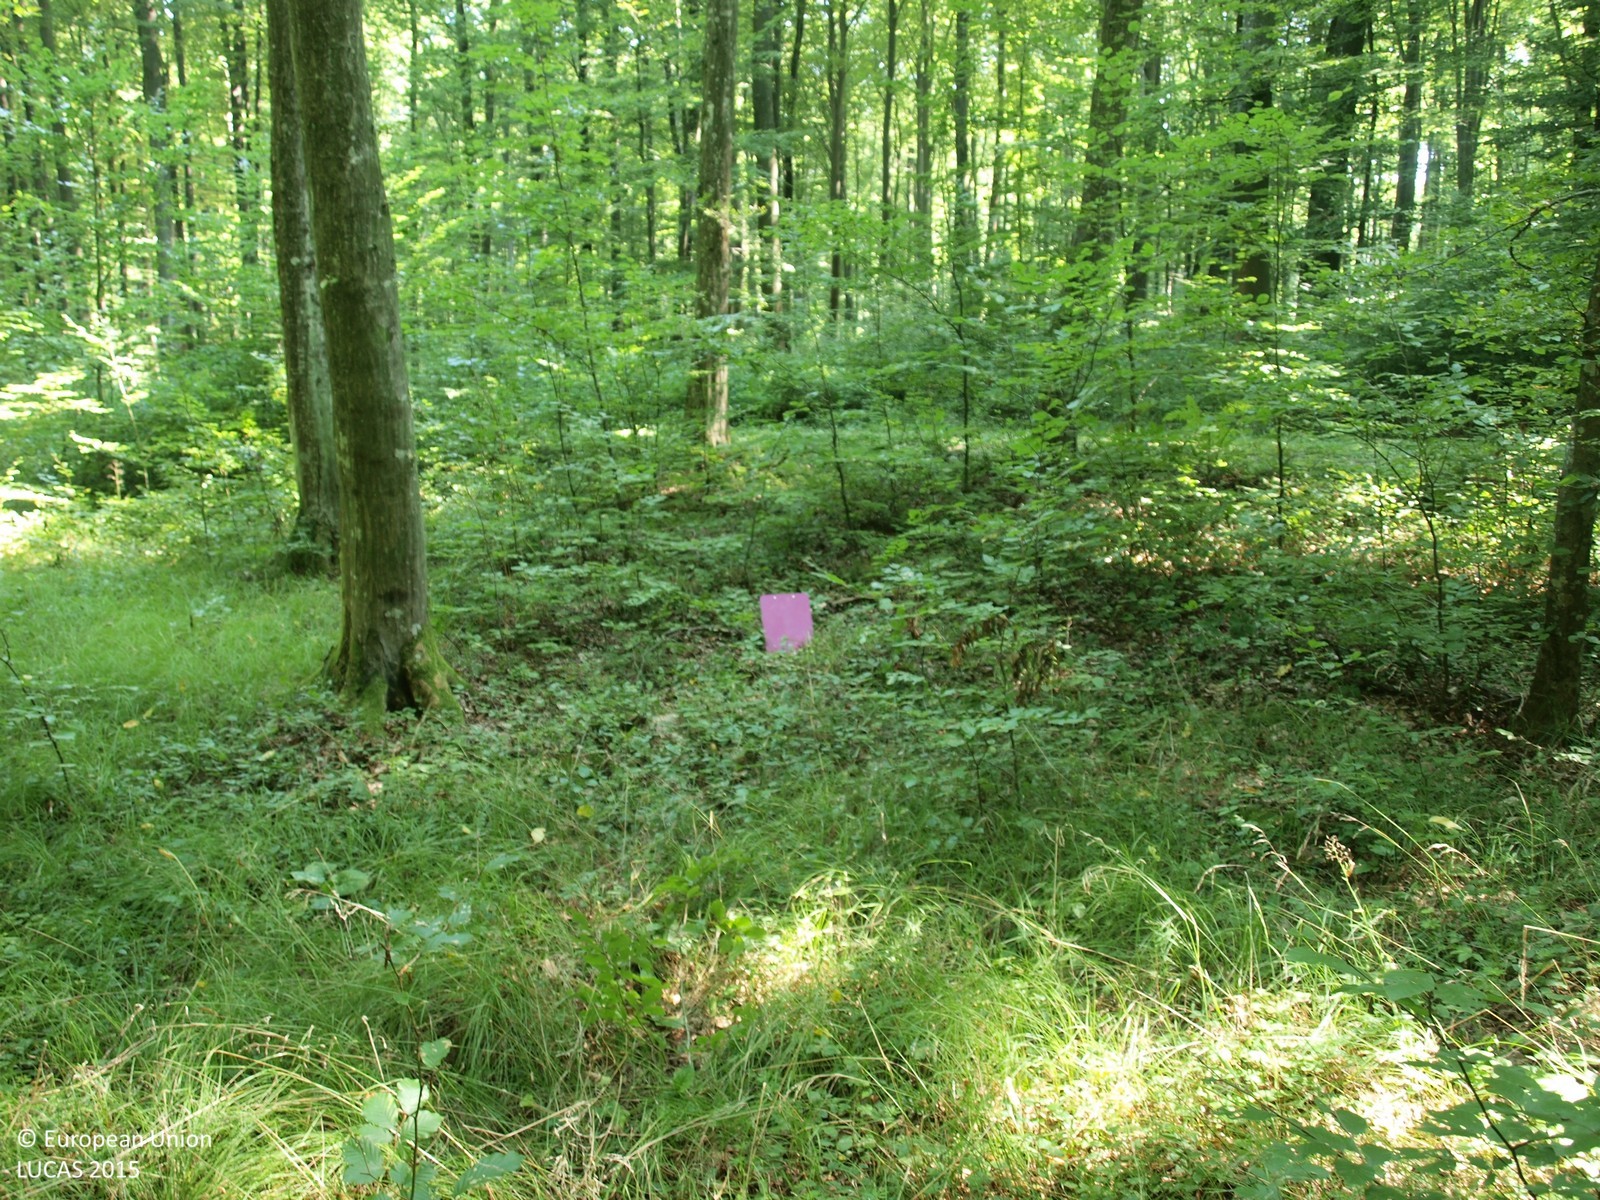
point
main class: Woodland
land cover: Broadleaved woodland
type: mesophytic deciduous forest
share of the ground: > 75 %
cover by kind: broadleaved forest trees 100 %
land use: Forestry
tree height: > 5 m
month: August
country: HR
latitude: 45.9327
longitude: 16.5642
